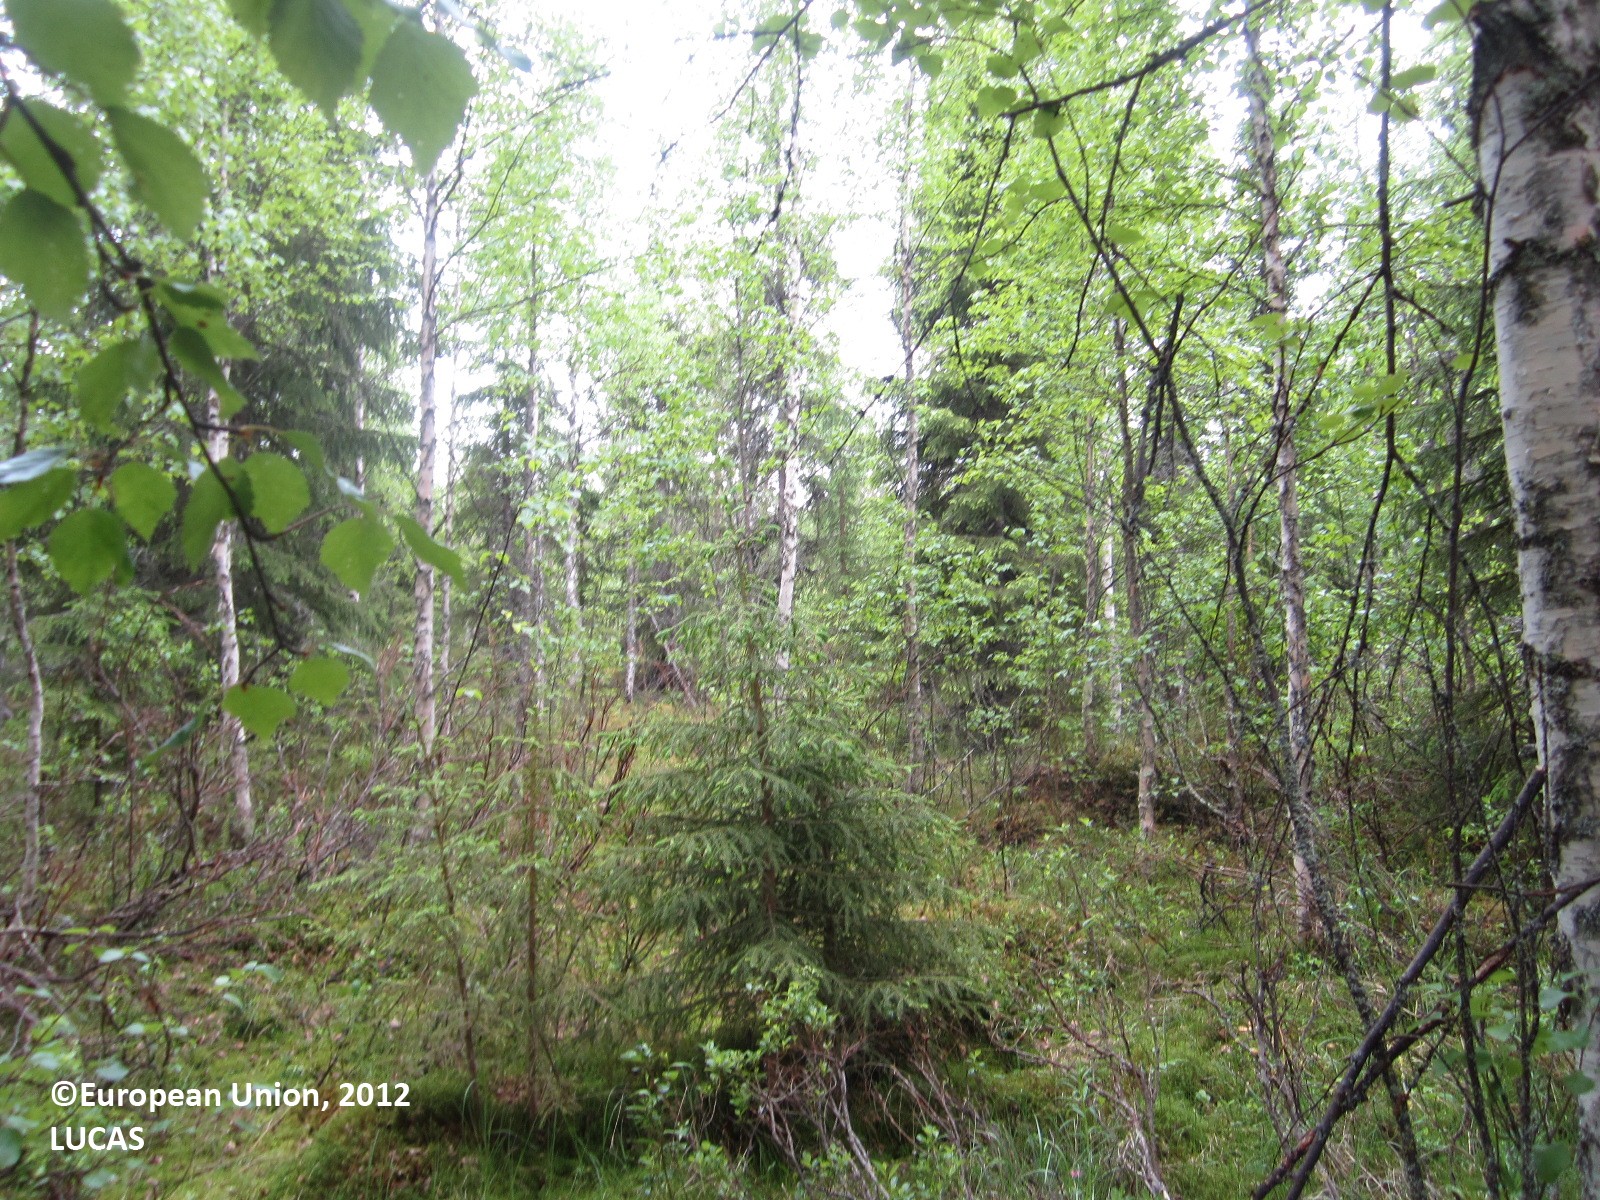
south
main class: Woodland
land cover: Broadleaved woodland
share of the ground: > 75 %
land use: Forestry
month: June
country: FI
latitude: 64.6990
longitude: 29.7007
